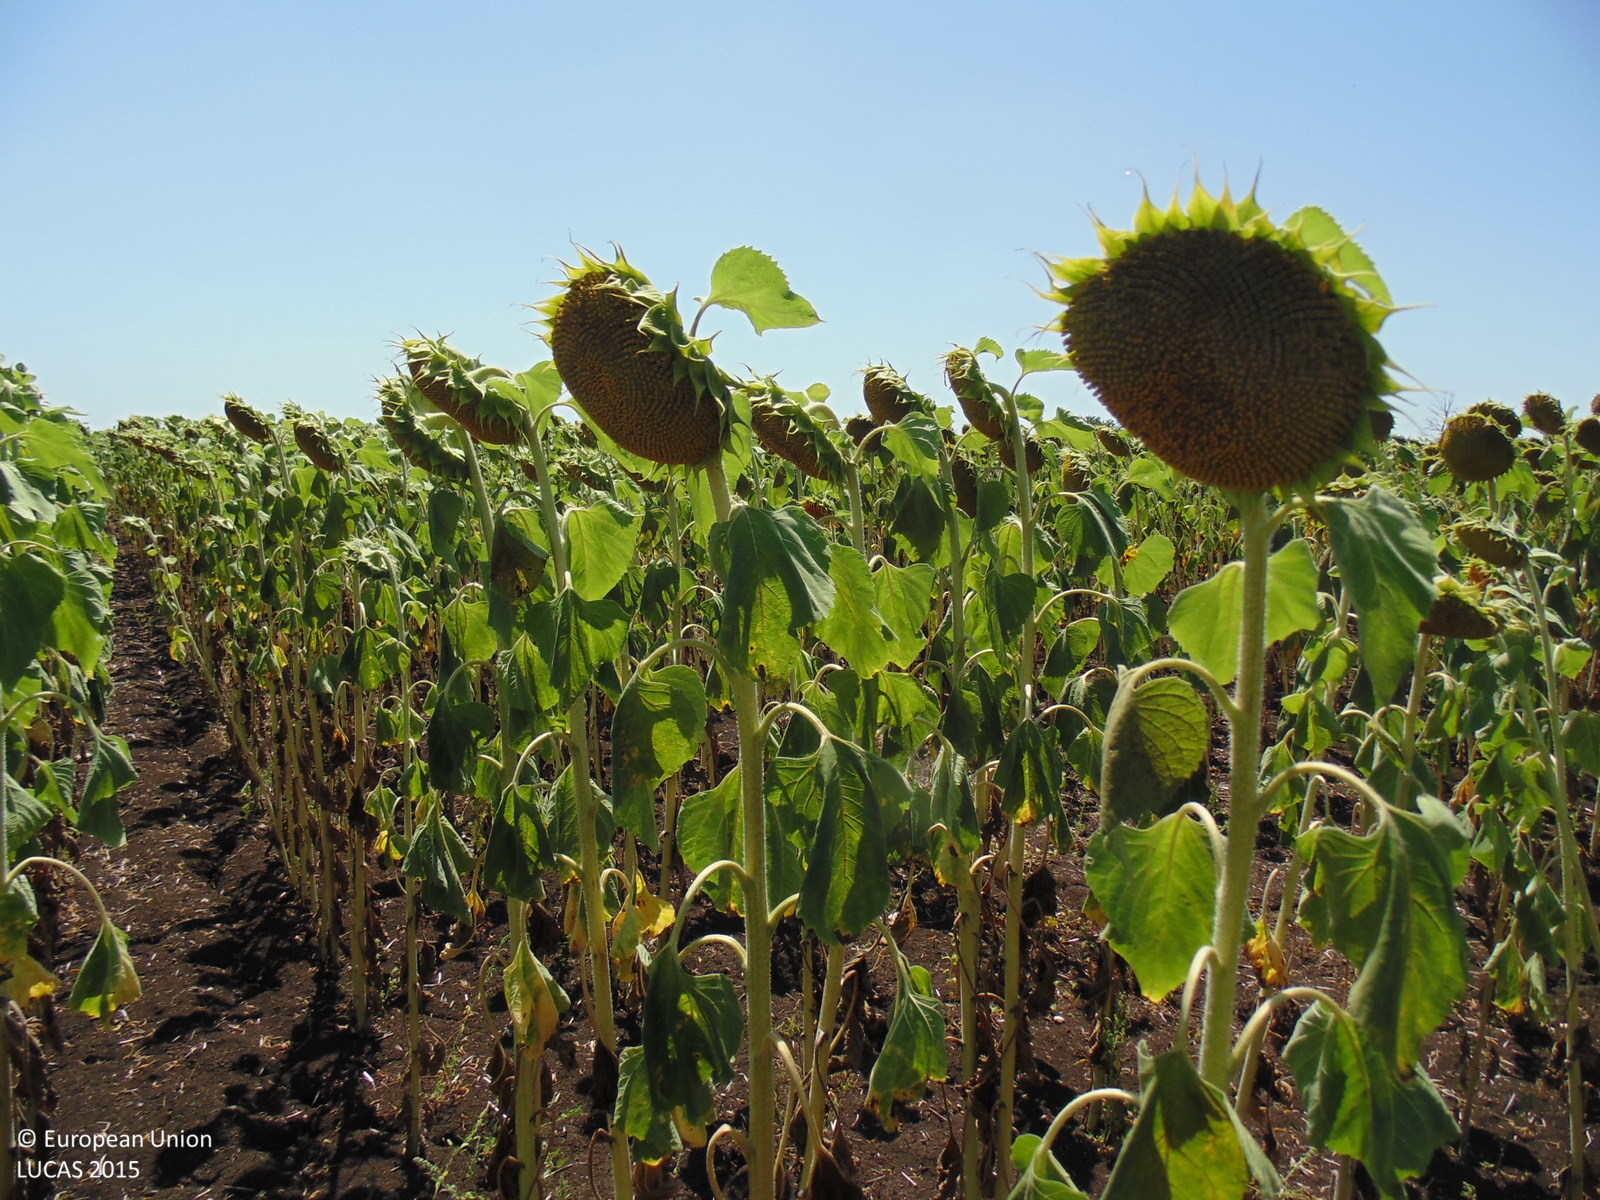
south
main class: Cropland
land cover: Sunflower
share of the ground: > 75 %
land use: Agriculture (excluding fallow land and kitchen gardens)
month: August
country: BG
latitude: 43.5045
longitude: 28.1716
